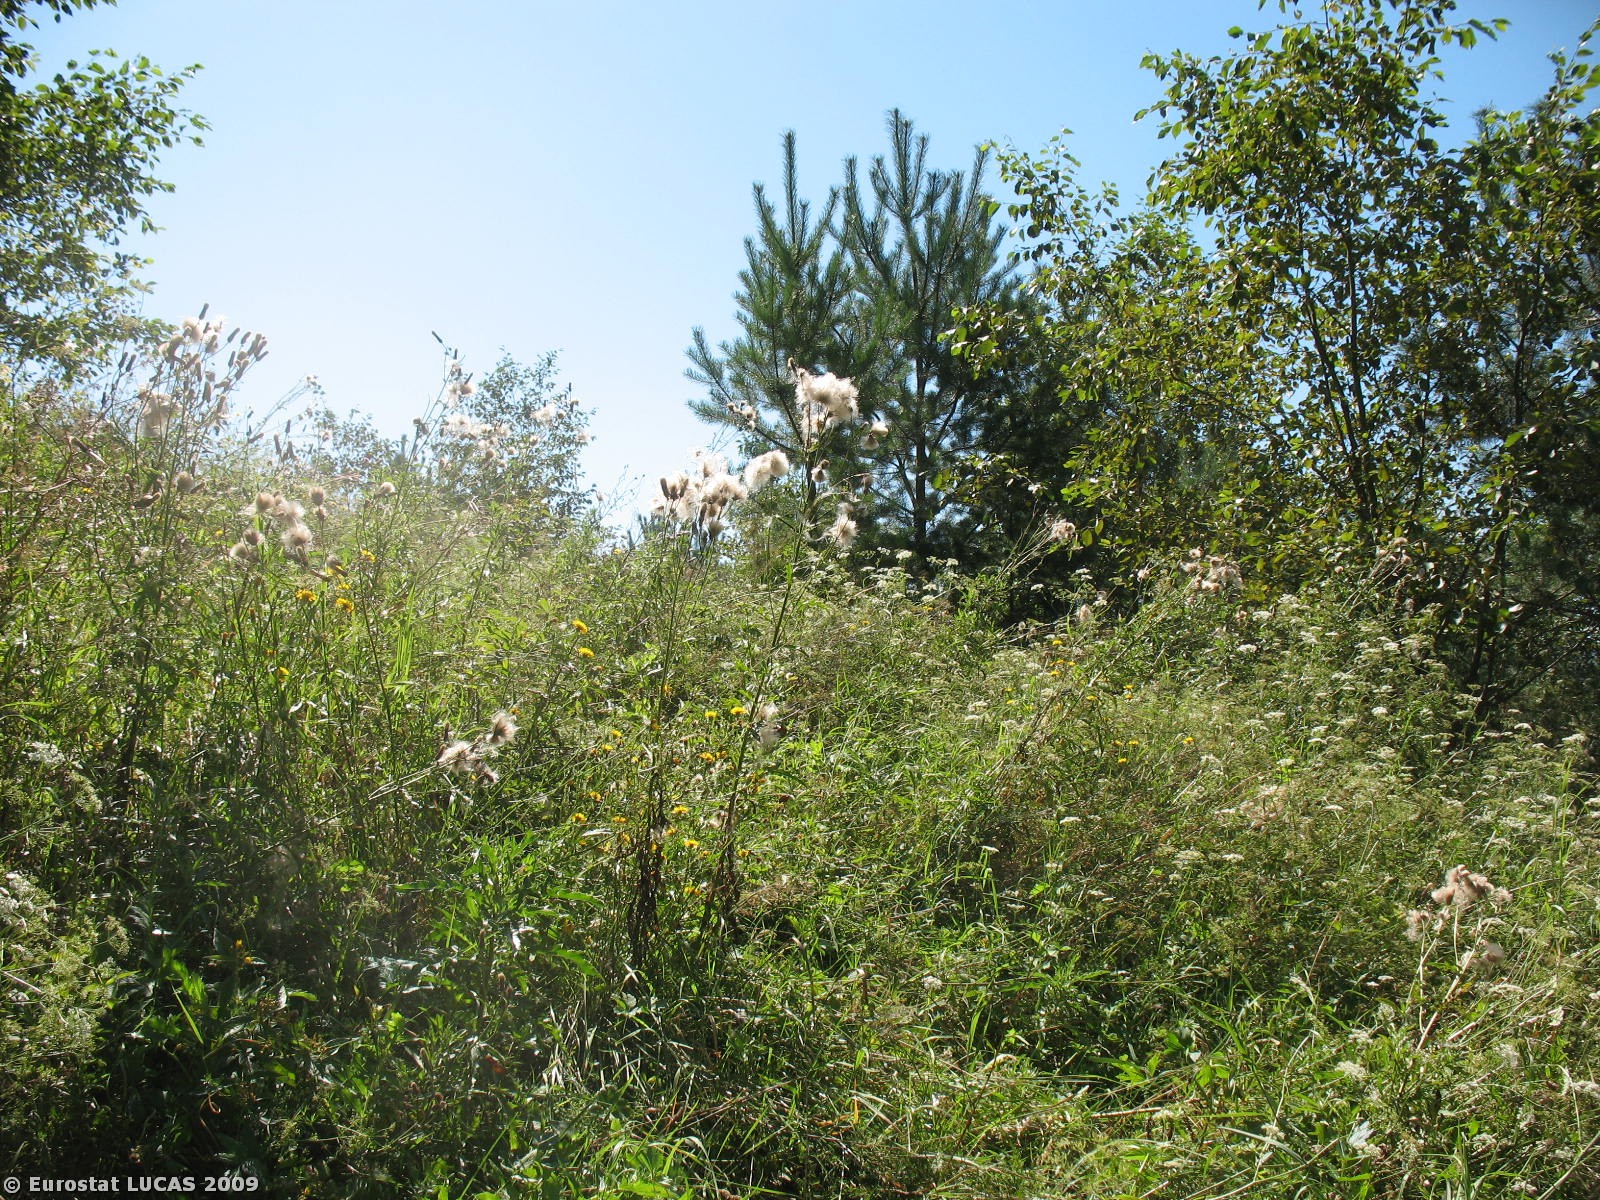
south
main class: Grassland
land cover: Spontaneously vegetated surfaces
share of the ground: > 75 %
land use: Unused
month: August
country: PL
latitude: 49.4697
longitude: 22.2171
